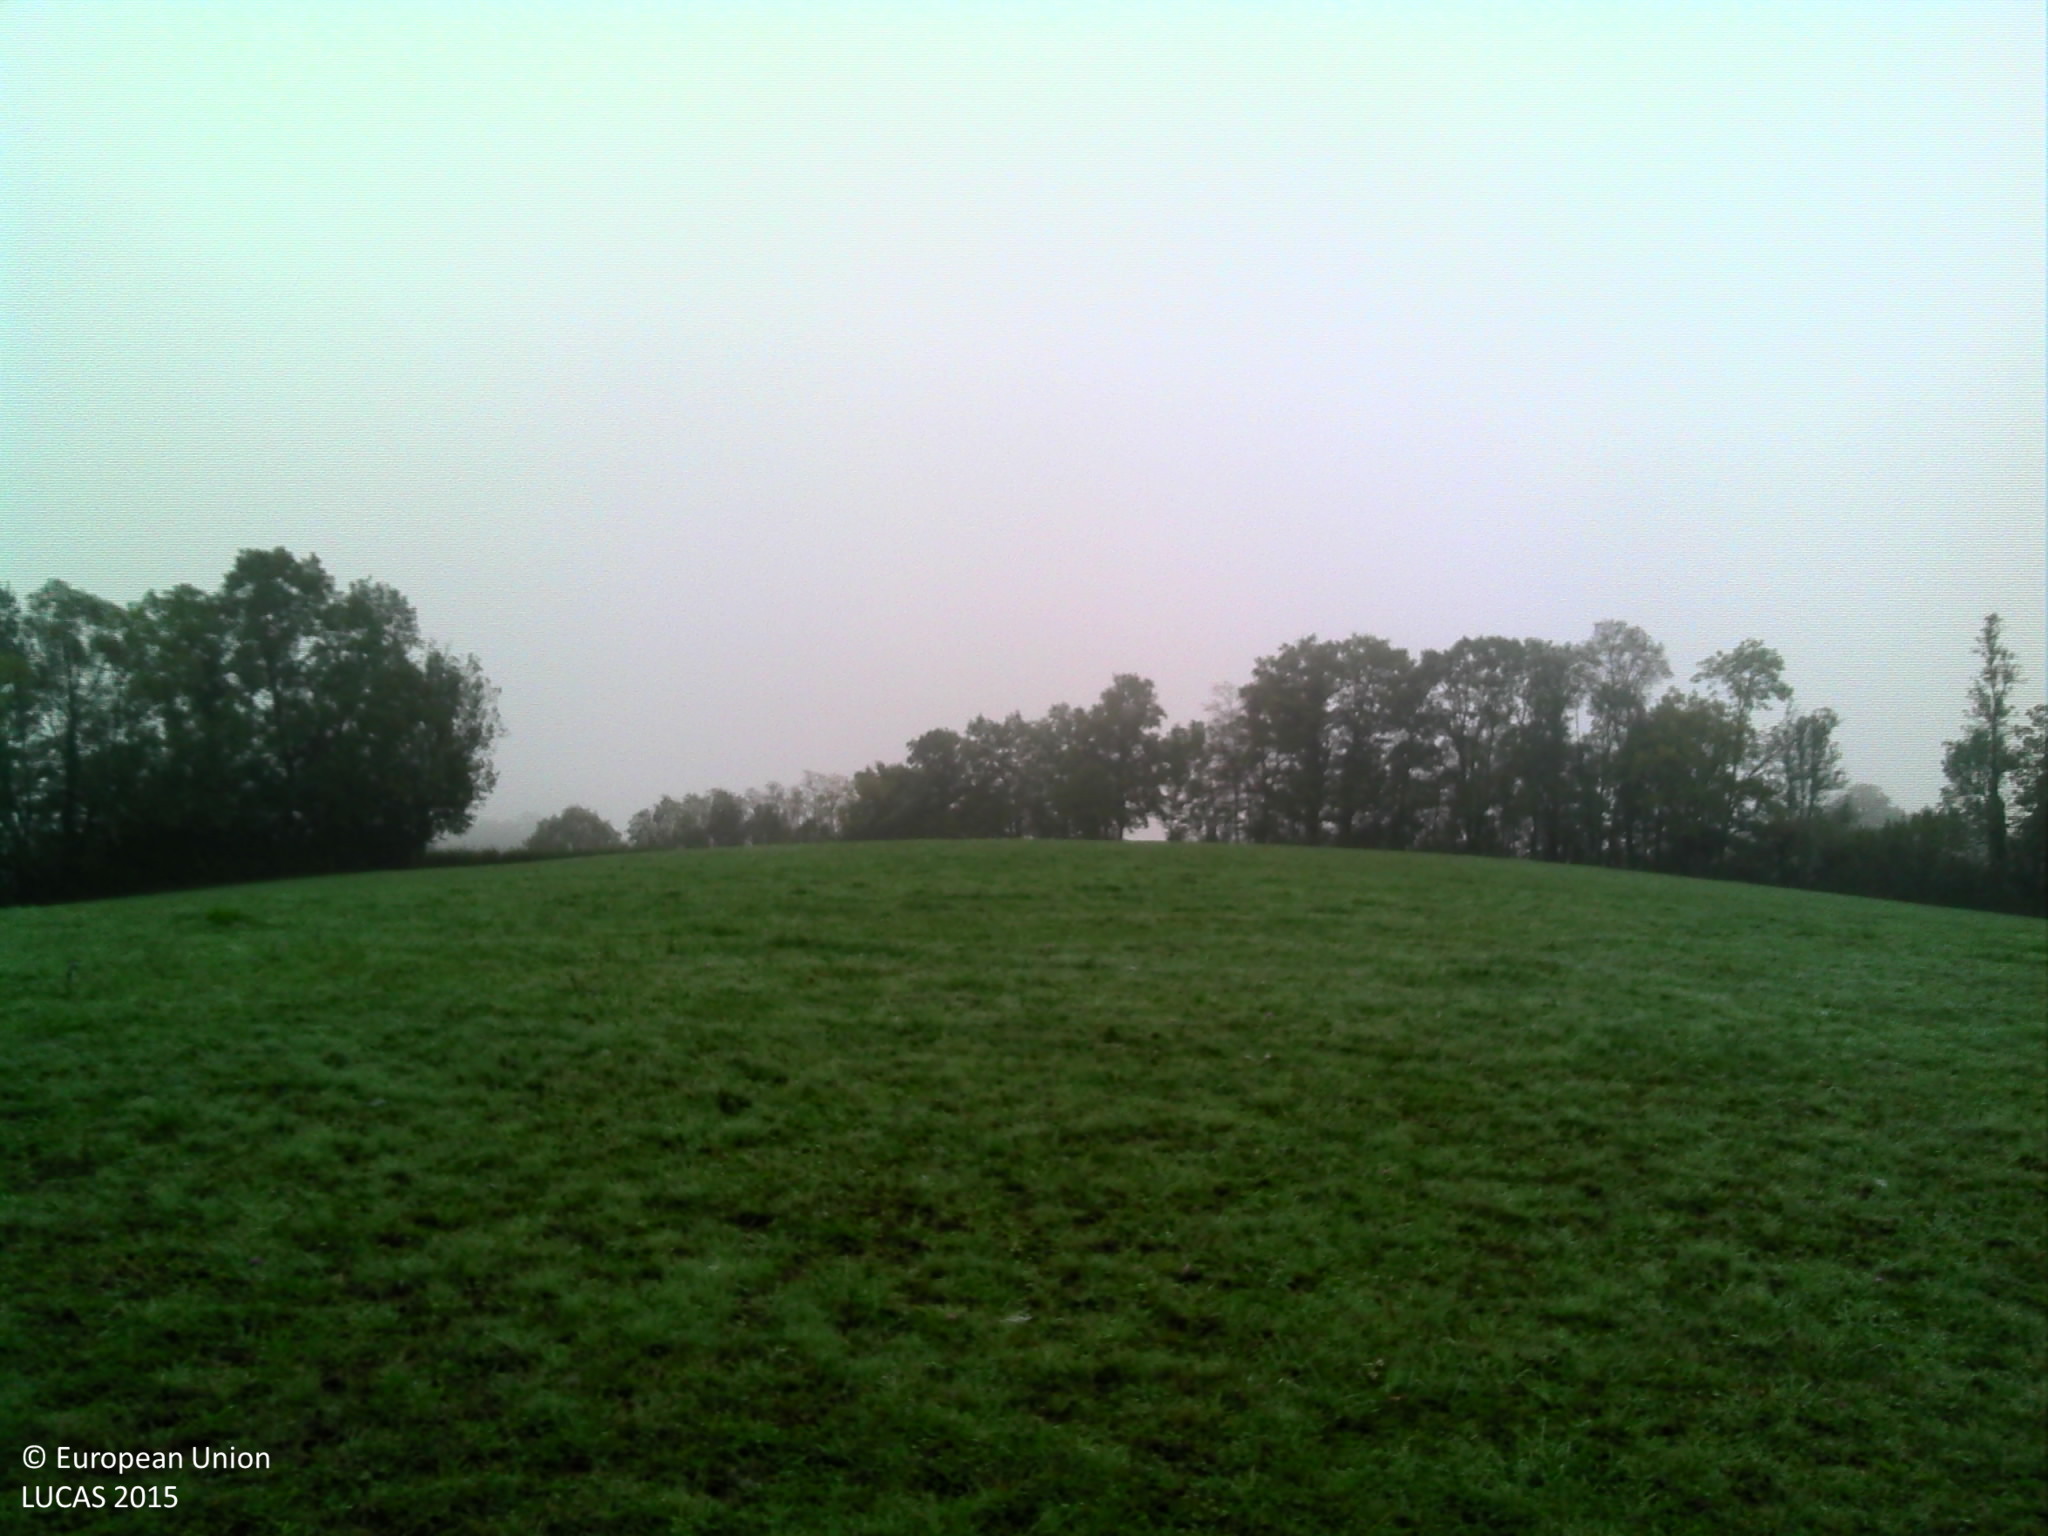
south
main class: Grassland
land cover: Grassland without tree/shrub cover
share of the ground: > 75 %
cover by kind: herbaceous plants 100 %
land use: Agriculture (excluding fallow land and kitchen gardens)
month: December
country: FR
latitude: 46.3294
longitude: 5.1055
